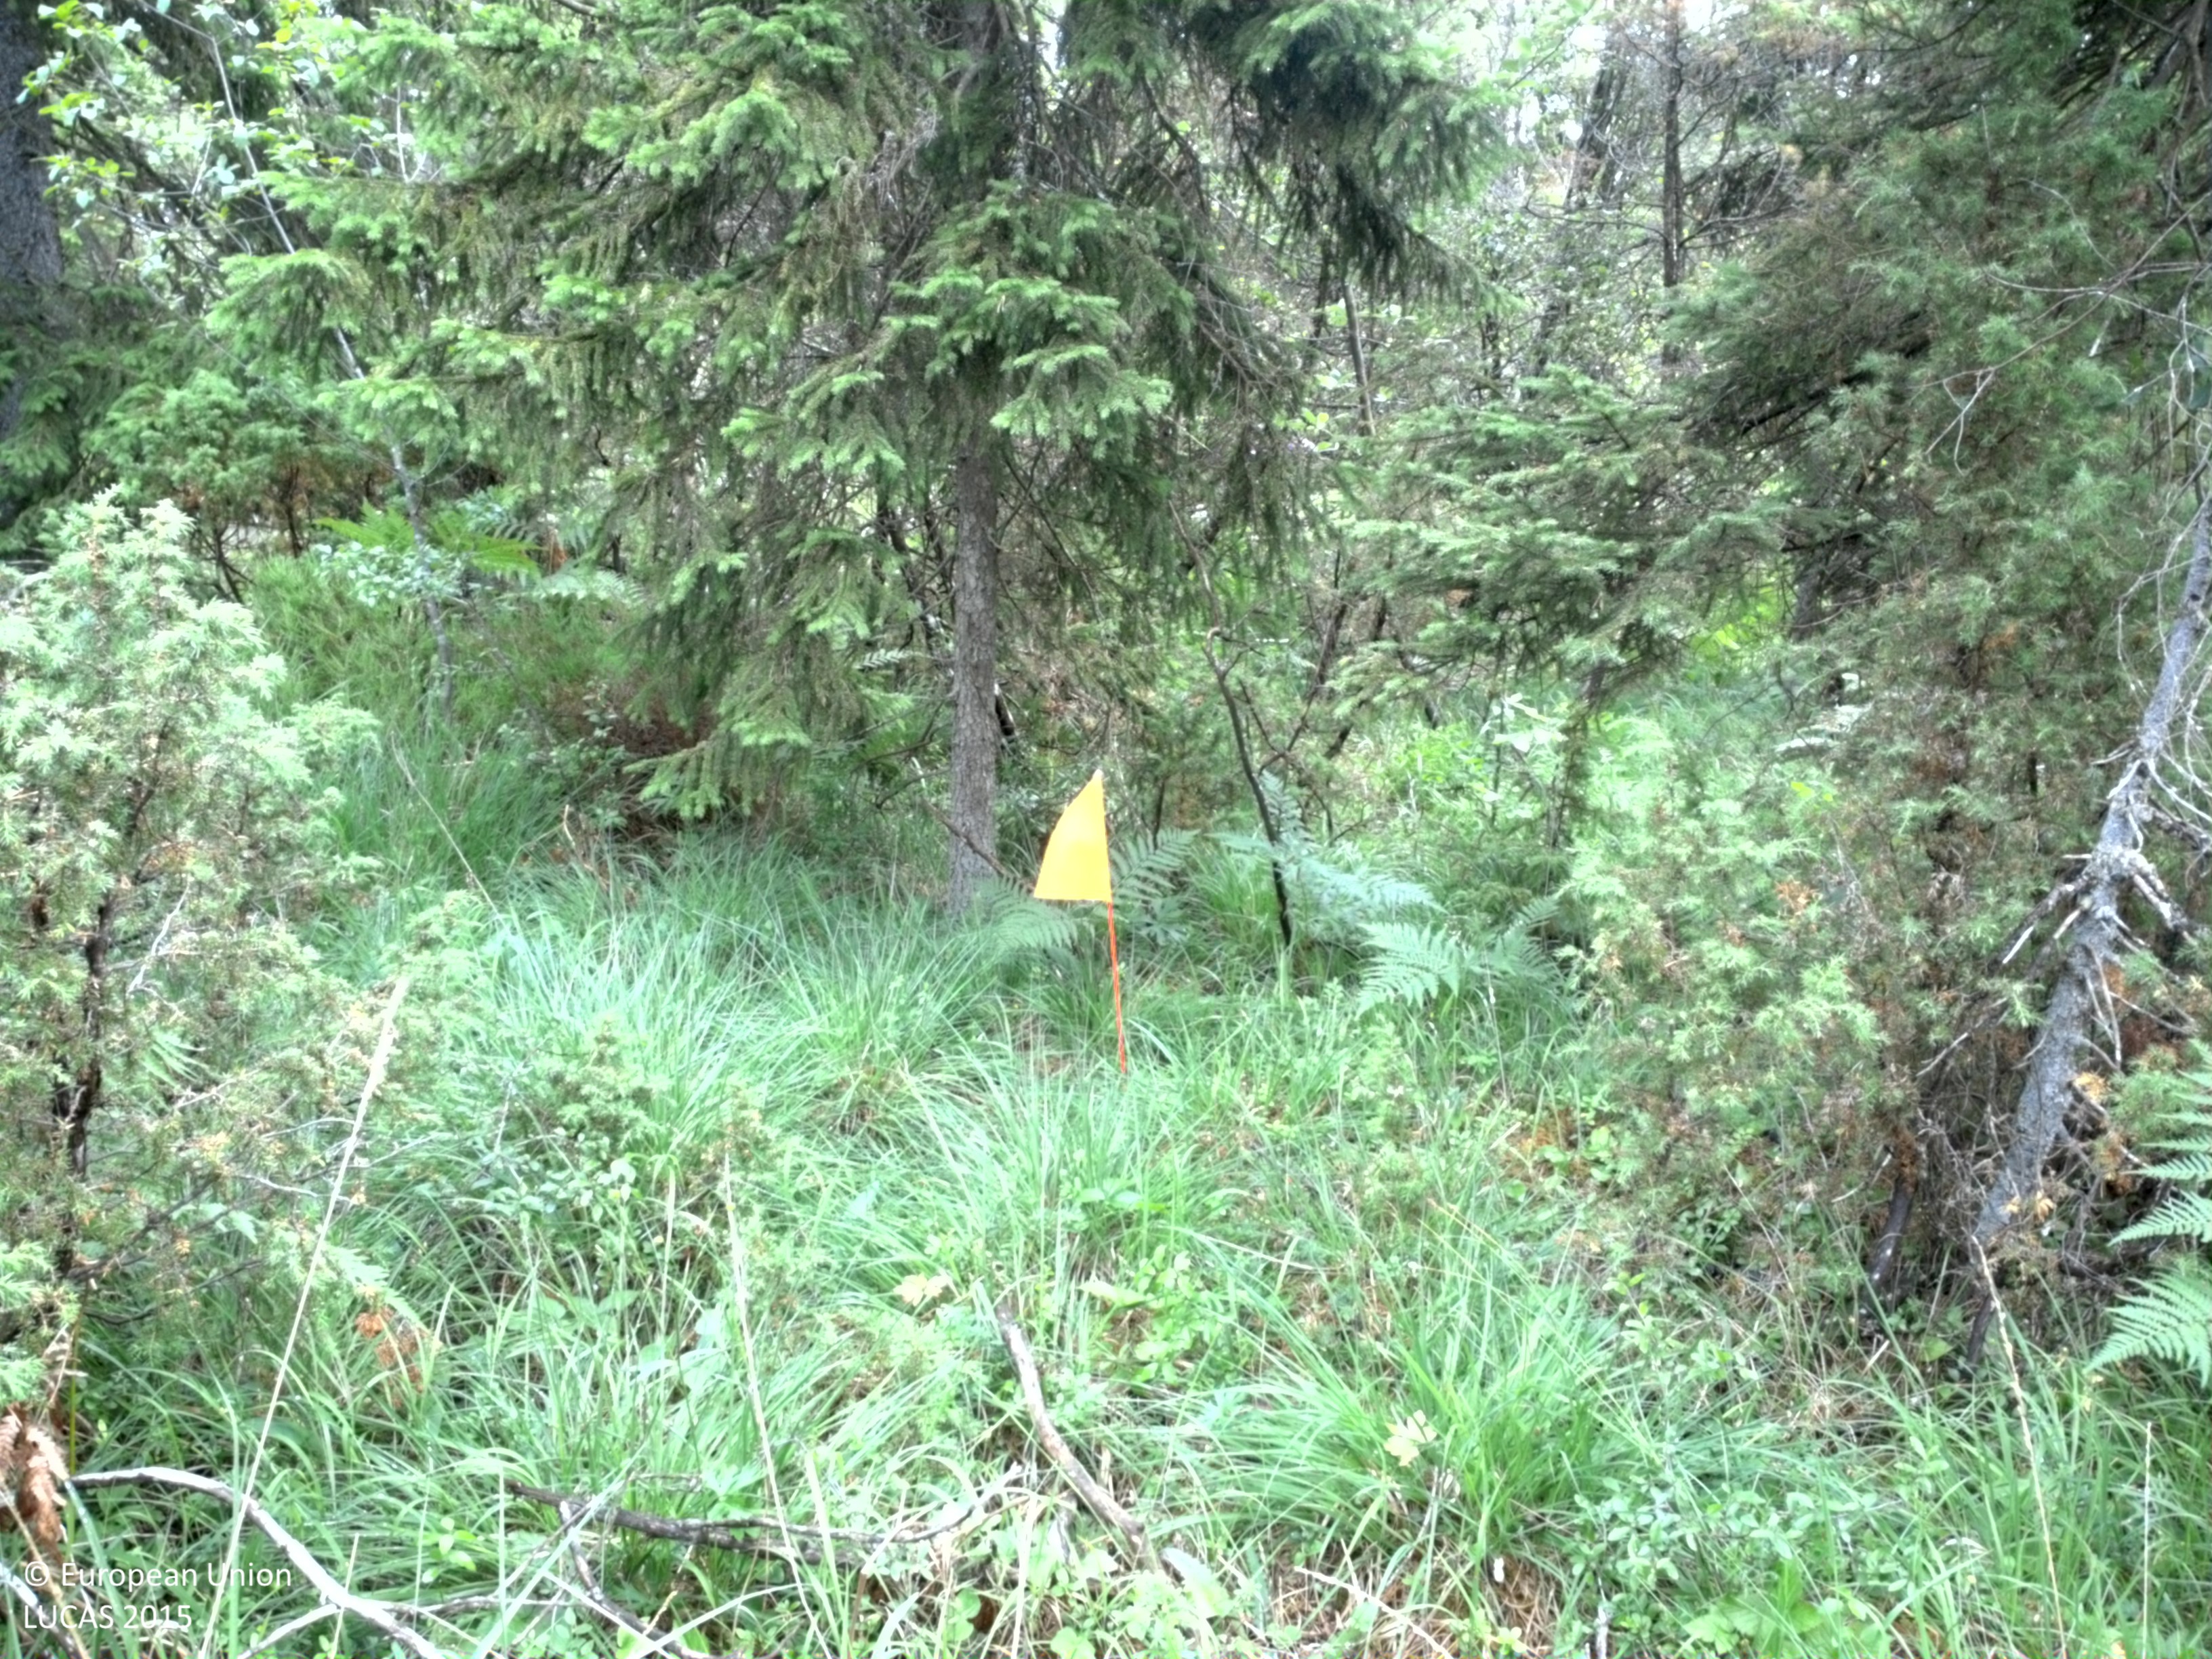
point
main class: Woodland
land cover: Other mixed woodland
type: hemiboreal forest and nemoral coniferous forest and mixed broadleaved-coniferous forest
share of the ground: 50 - 75 %
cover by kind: coniferous forest trees 50 %, broadleaved forest trees 20 %, shrubs 15 %, herbaceous plants 15 %
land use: Forestry
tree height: > 5 m
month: July
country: SE
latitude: 57.4088
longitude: 18.7497
